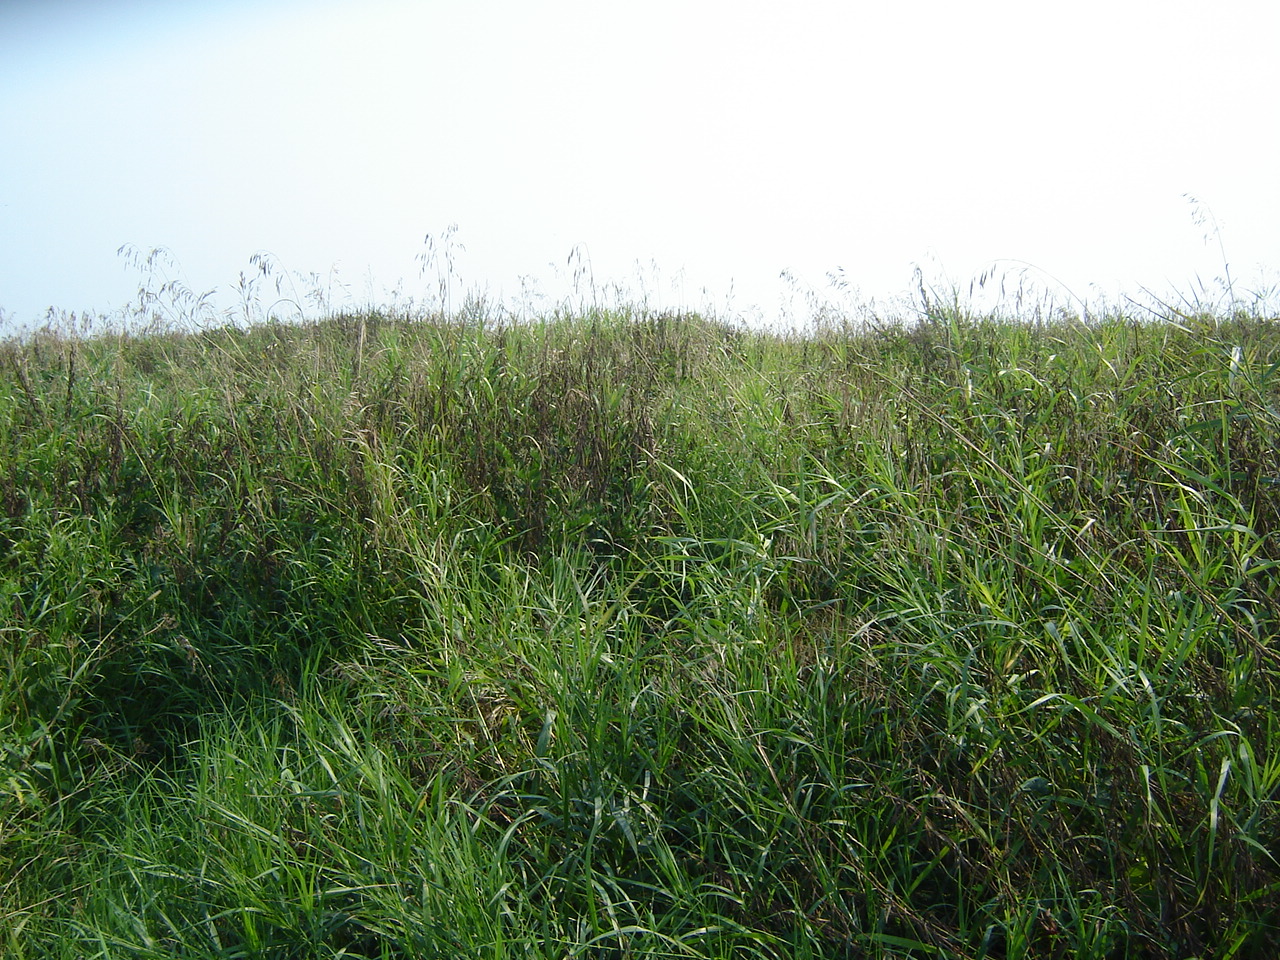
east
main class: Grassland
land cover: Spontaneously vegetated surfaces
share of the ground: > 75 %
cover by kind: herbaceous plants 100 %
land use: Fallow land
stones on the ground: < 10 %
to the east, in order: Spontaneously vegetated surfaces; Grassland without tree/shrub cover
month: August
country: LT
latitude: 54.8738
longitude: 25.0285
